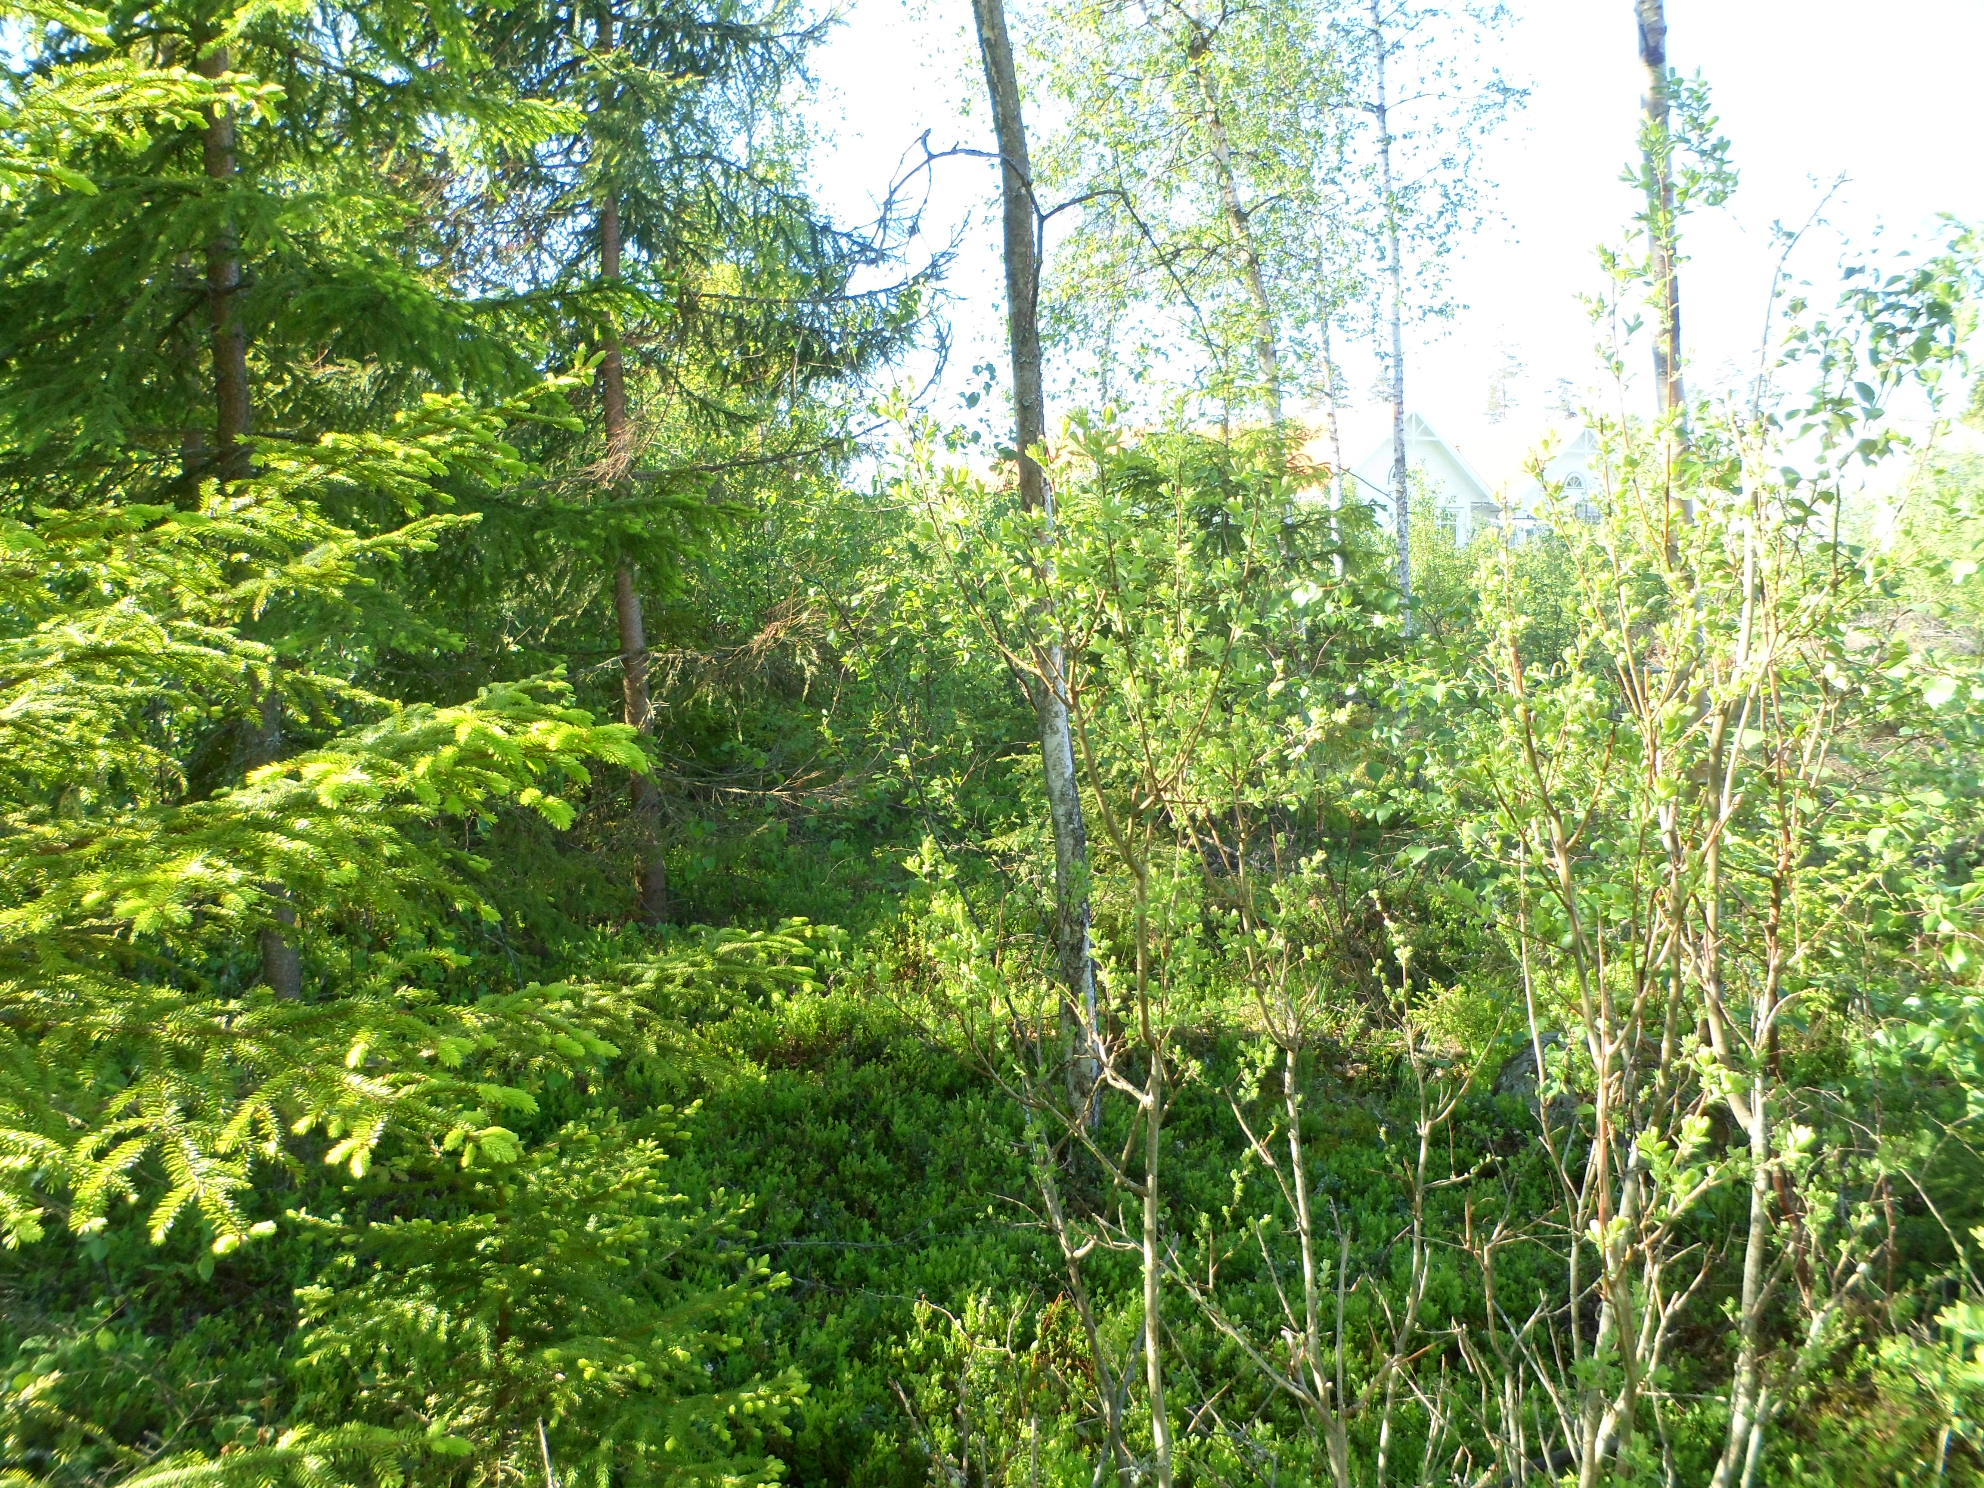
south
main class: Woodland
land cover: Spruce dominated mixed woodland
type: boreal forest
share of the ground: 50 - 75 %
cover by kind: coniferous forest trees 30 %, broadleaved forest trees 30 %, shrubs 25 %, lichens and mosses 10 %, herbaceous plants 5 %
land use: Forestry
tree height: > 5 m
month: June
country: SE
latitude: 56.8879
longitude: 14.8720
